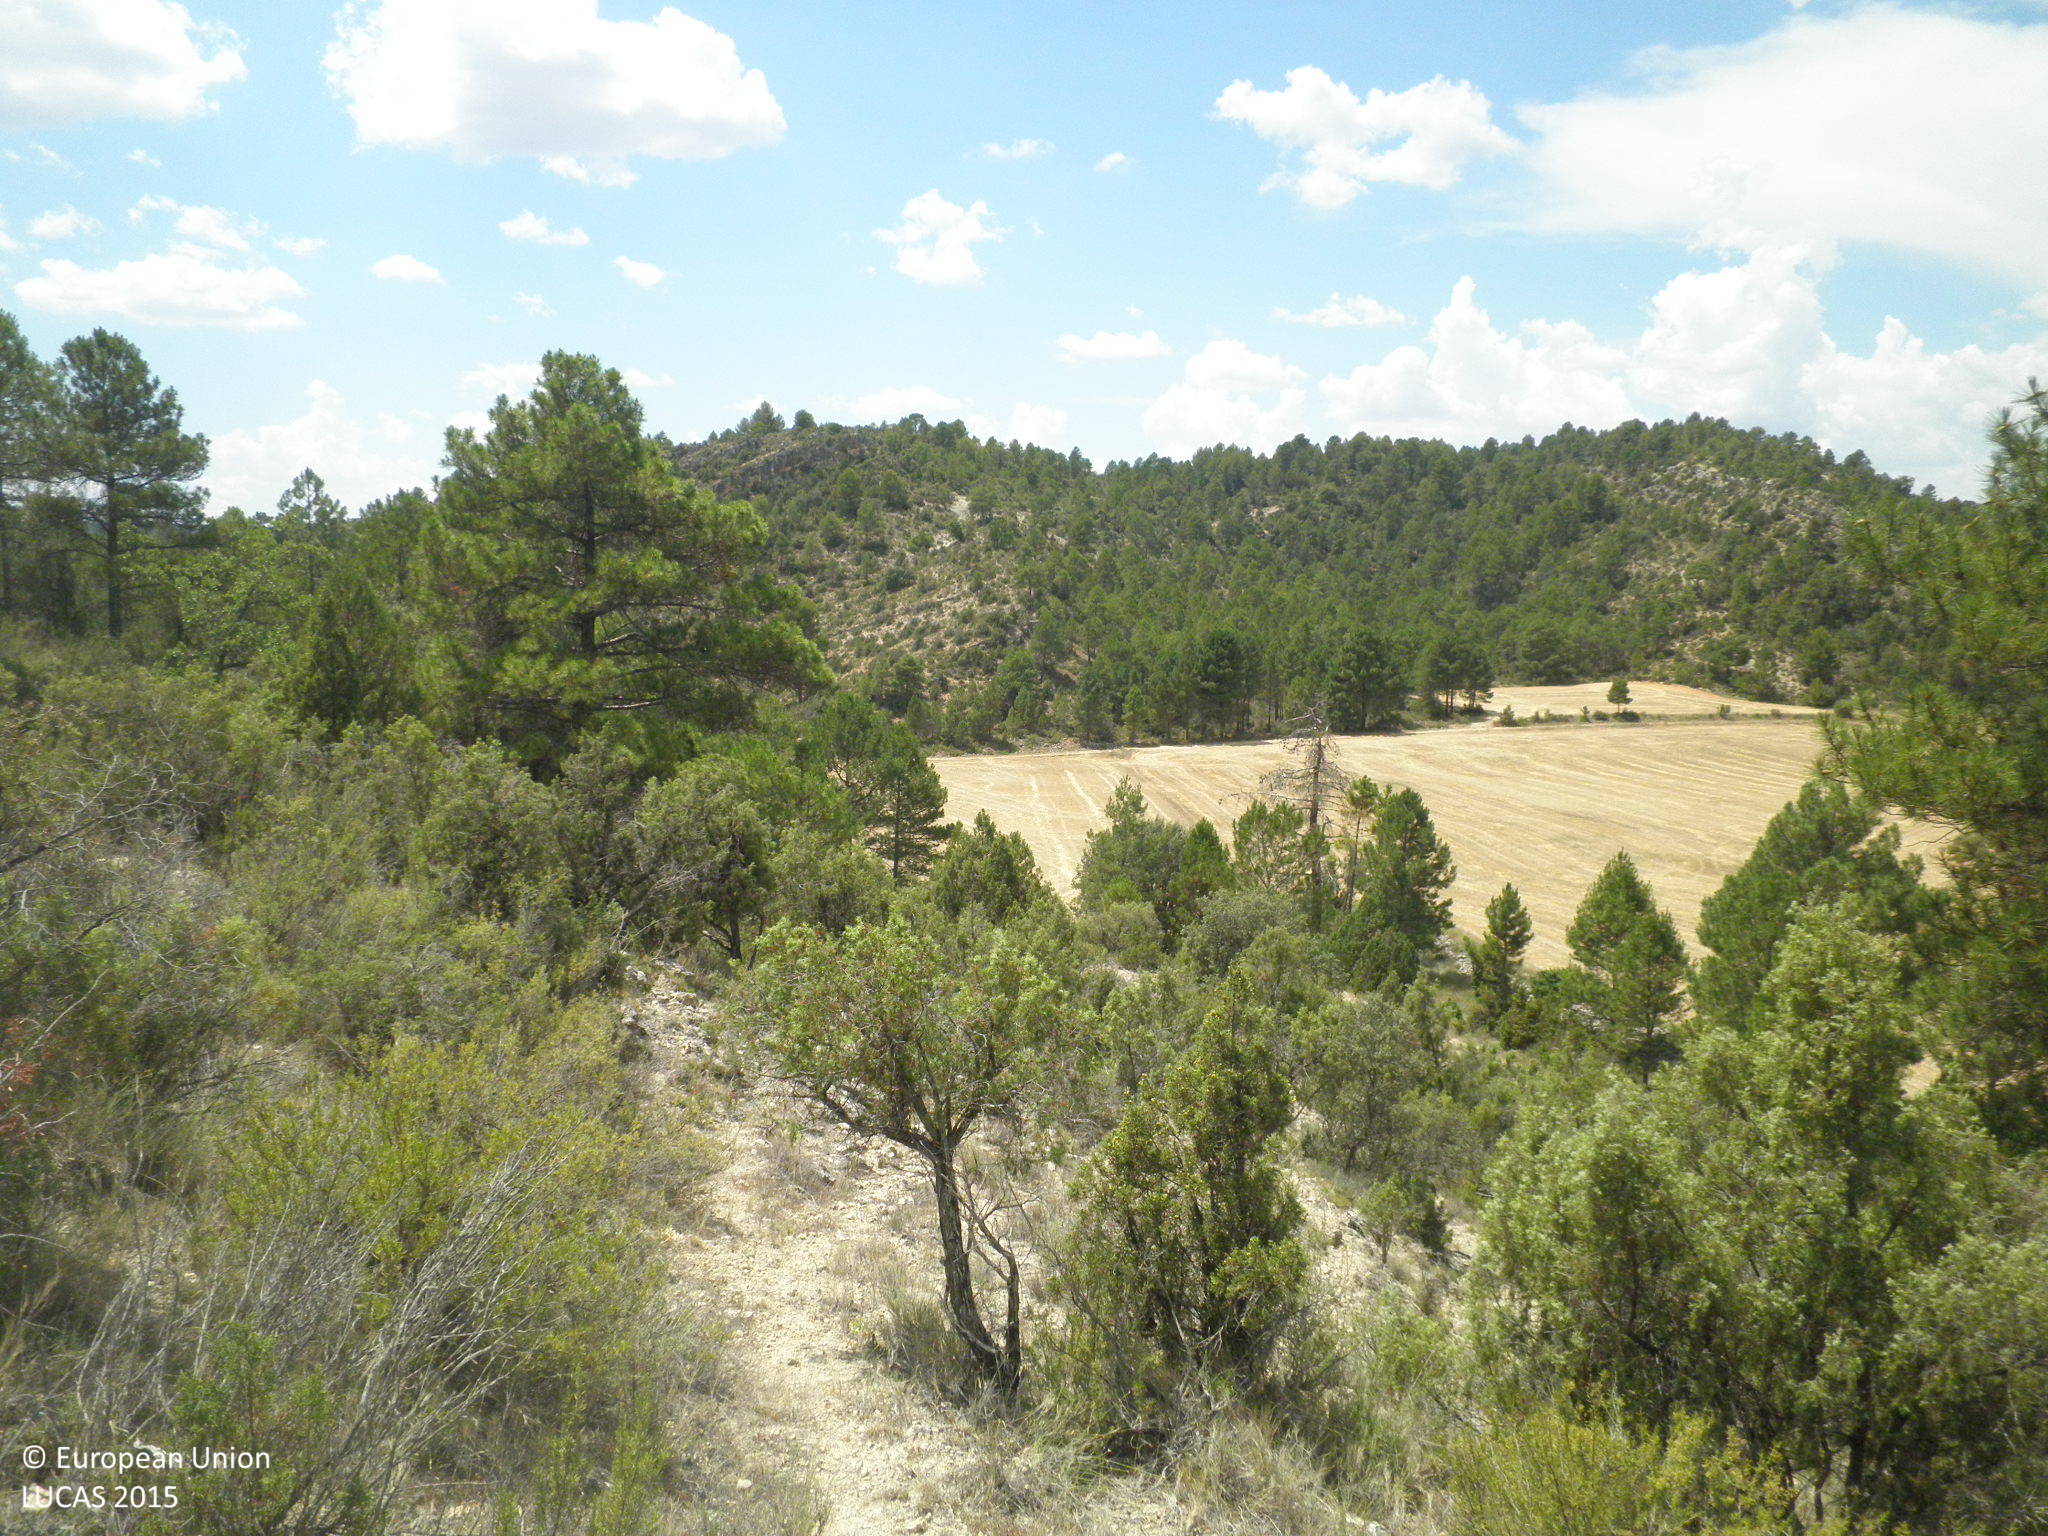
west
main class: Woodland
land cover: Pine dominated coniferous woodland
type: coniferous forest of the mediterranean region
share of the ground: 10 - 25 %
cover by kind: unconsolidated bare surface 50 %, shrubs 40 %, coniferous forest trees 10 %
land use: Semi-natural and natural areas not in use
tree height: > 5 m
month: July
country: ES
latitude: 39.7346
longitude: -1.8056
